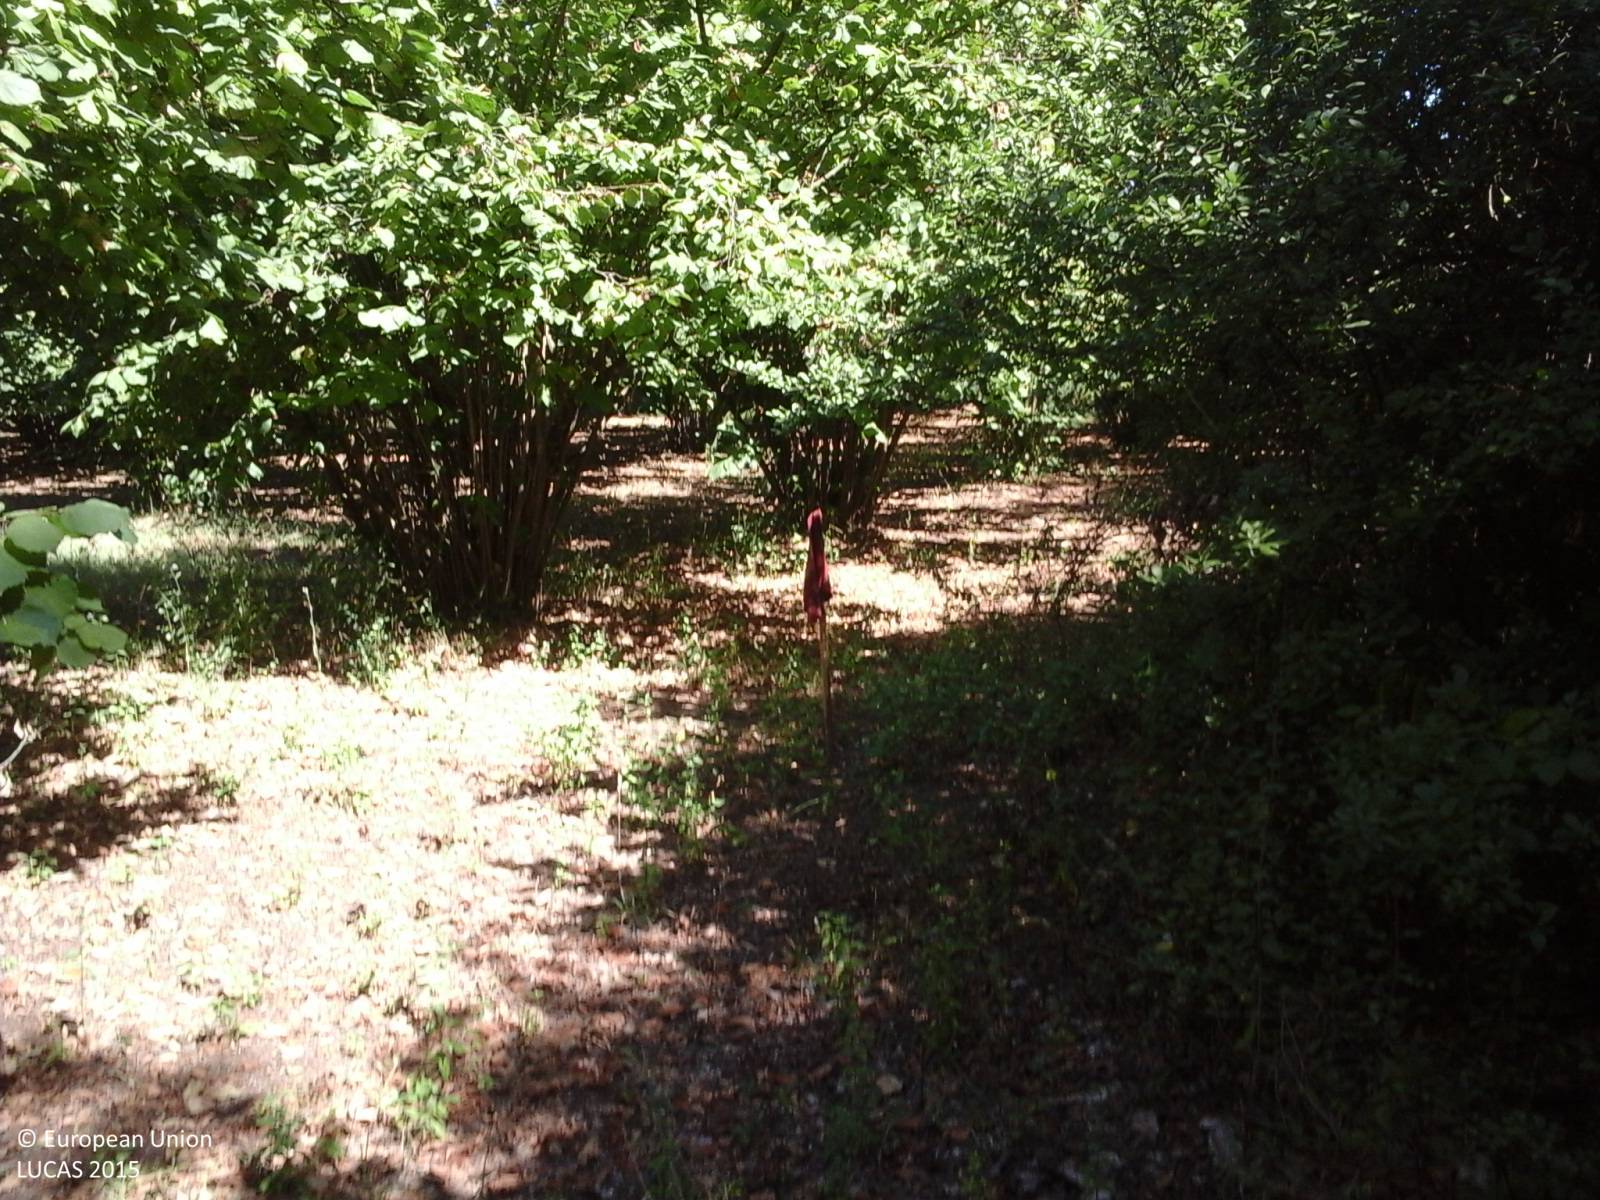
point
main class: Cropland
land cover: Nuts trees
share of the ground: > 75 %
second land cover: Spontaneously vegetated surfaces
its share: 10 - 25 %
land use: Agriculture (excluding fallow land and kitchen gardens)
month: July
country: IT
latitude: 42.1919
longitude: 12.4012
